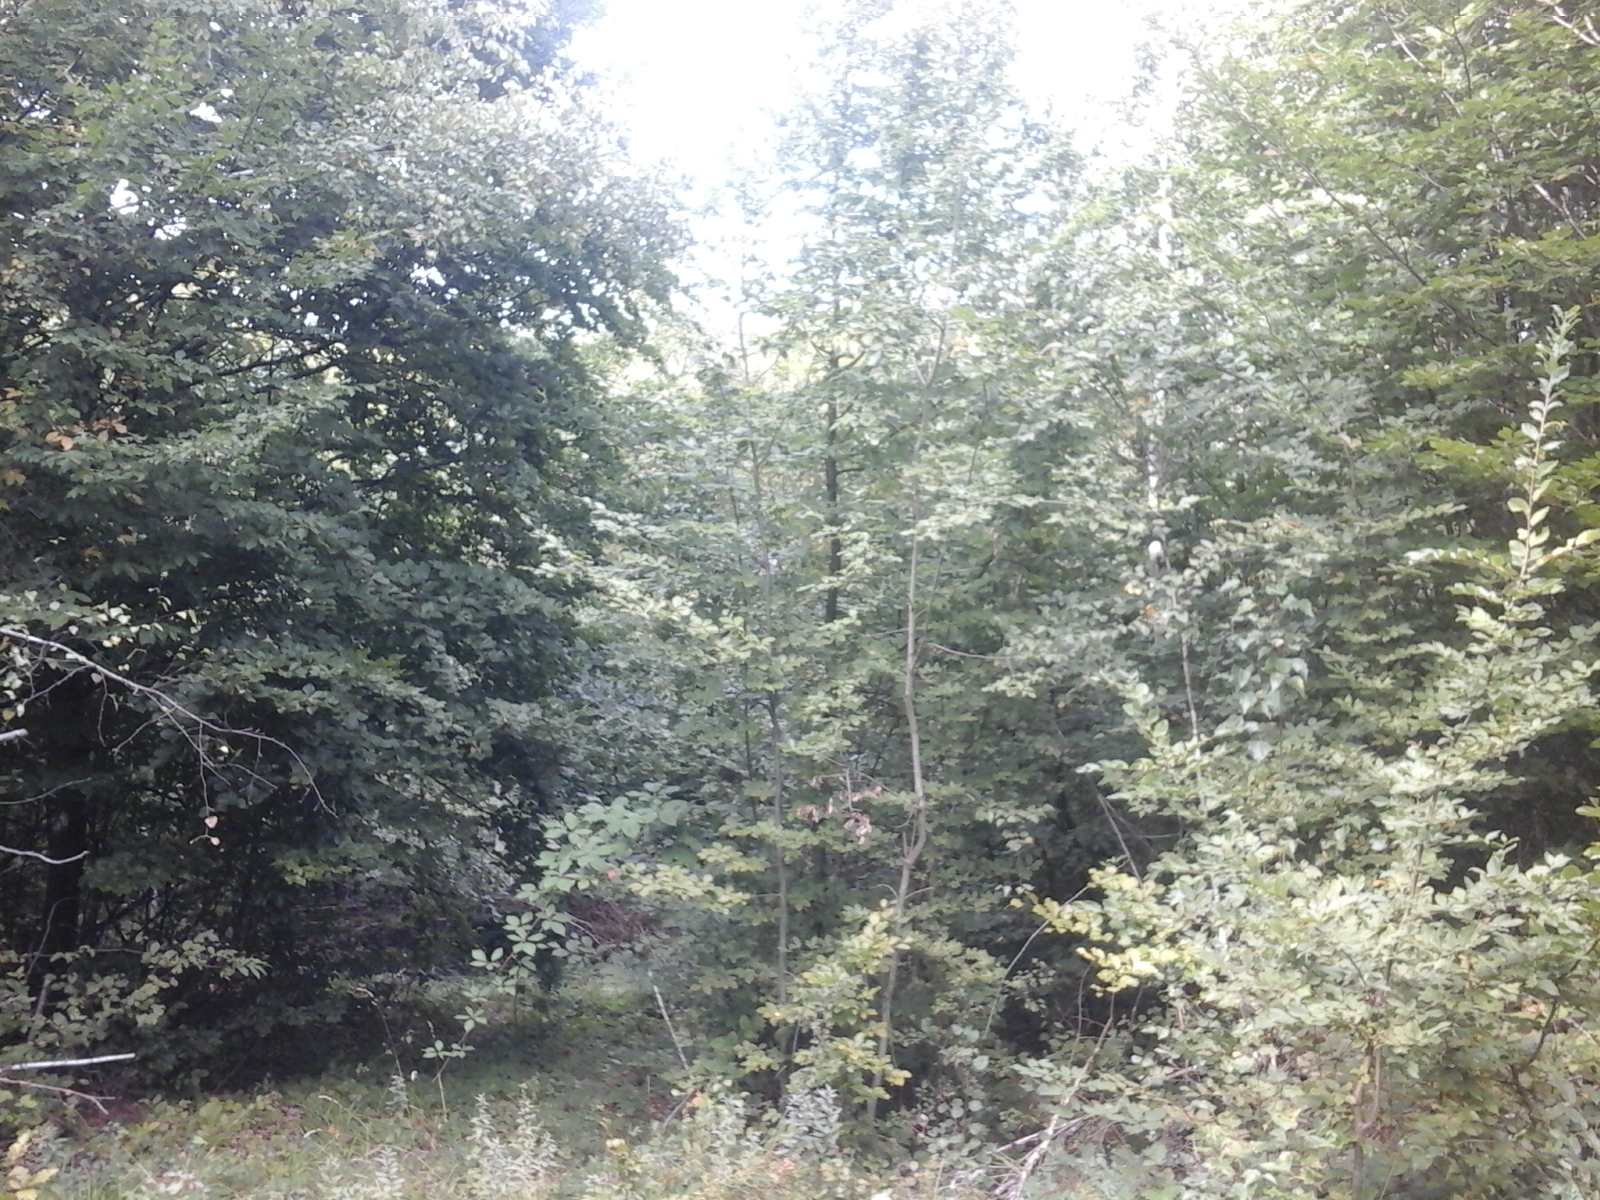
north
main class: Woodland
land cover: Broadleaved woodland
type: mesophytic deciduous forest
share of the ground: > 75 %
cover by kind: broadleaved forest trees 100 %
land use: Forestry
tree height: > 5 m
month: September
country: RO
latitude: 47.4512
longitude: 23.7253
